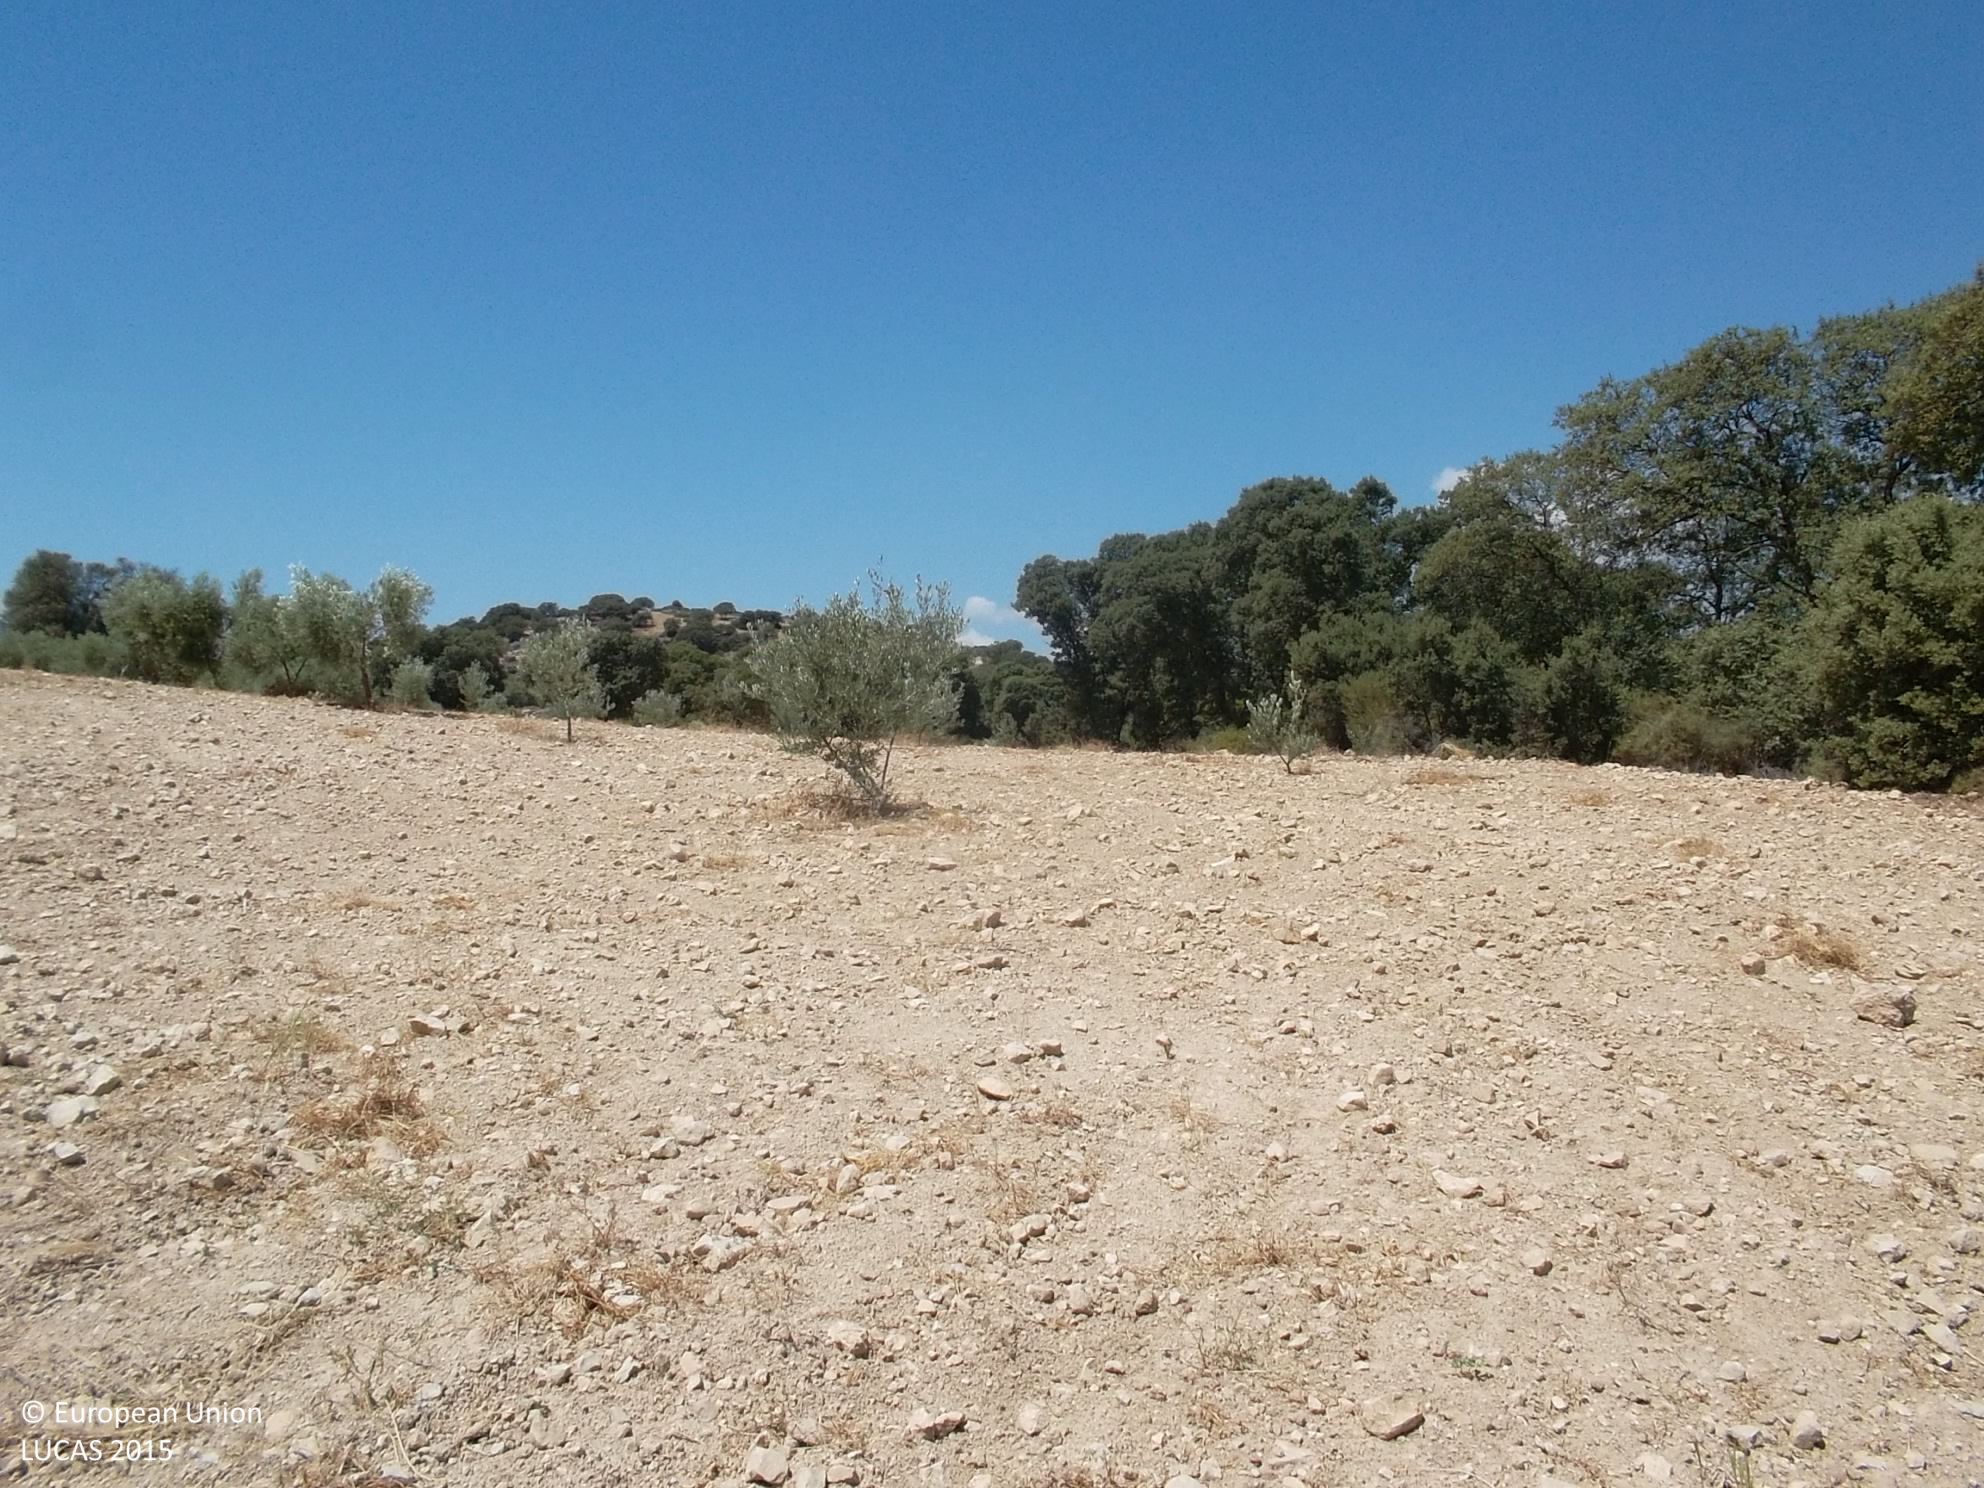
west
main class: Cropland
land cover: Olive groves
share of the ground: 10 - 25 %
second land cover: Other bare soil
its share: > 75 %
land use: Agriculture (excluding fallow land and kitchen gardens)
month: June
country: ES
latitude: 37.6659
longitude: -3.3378
